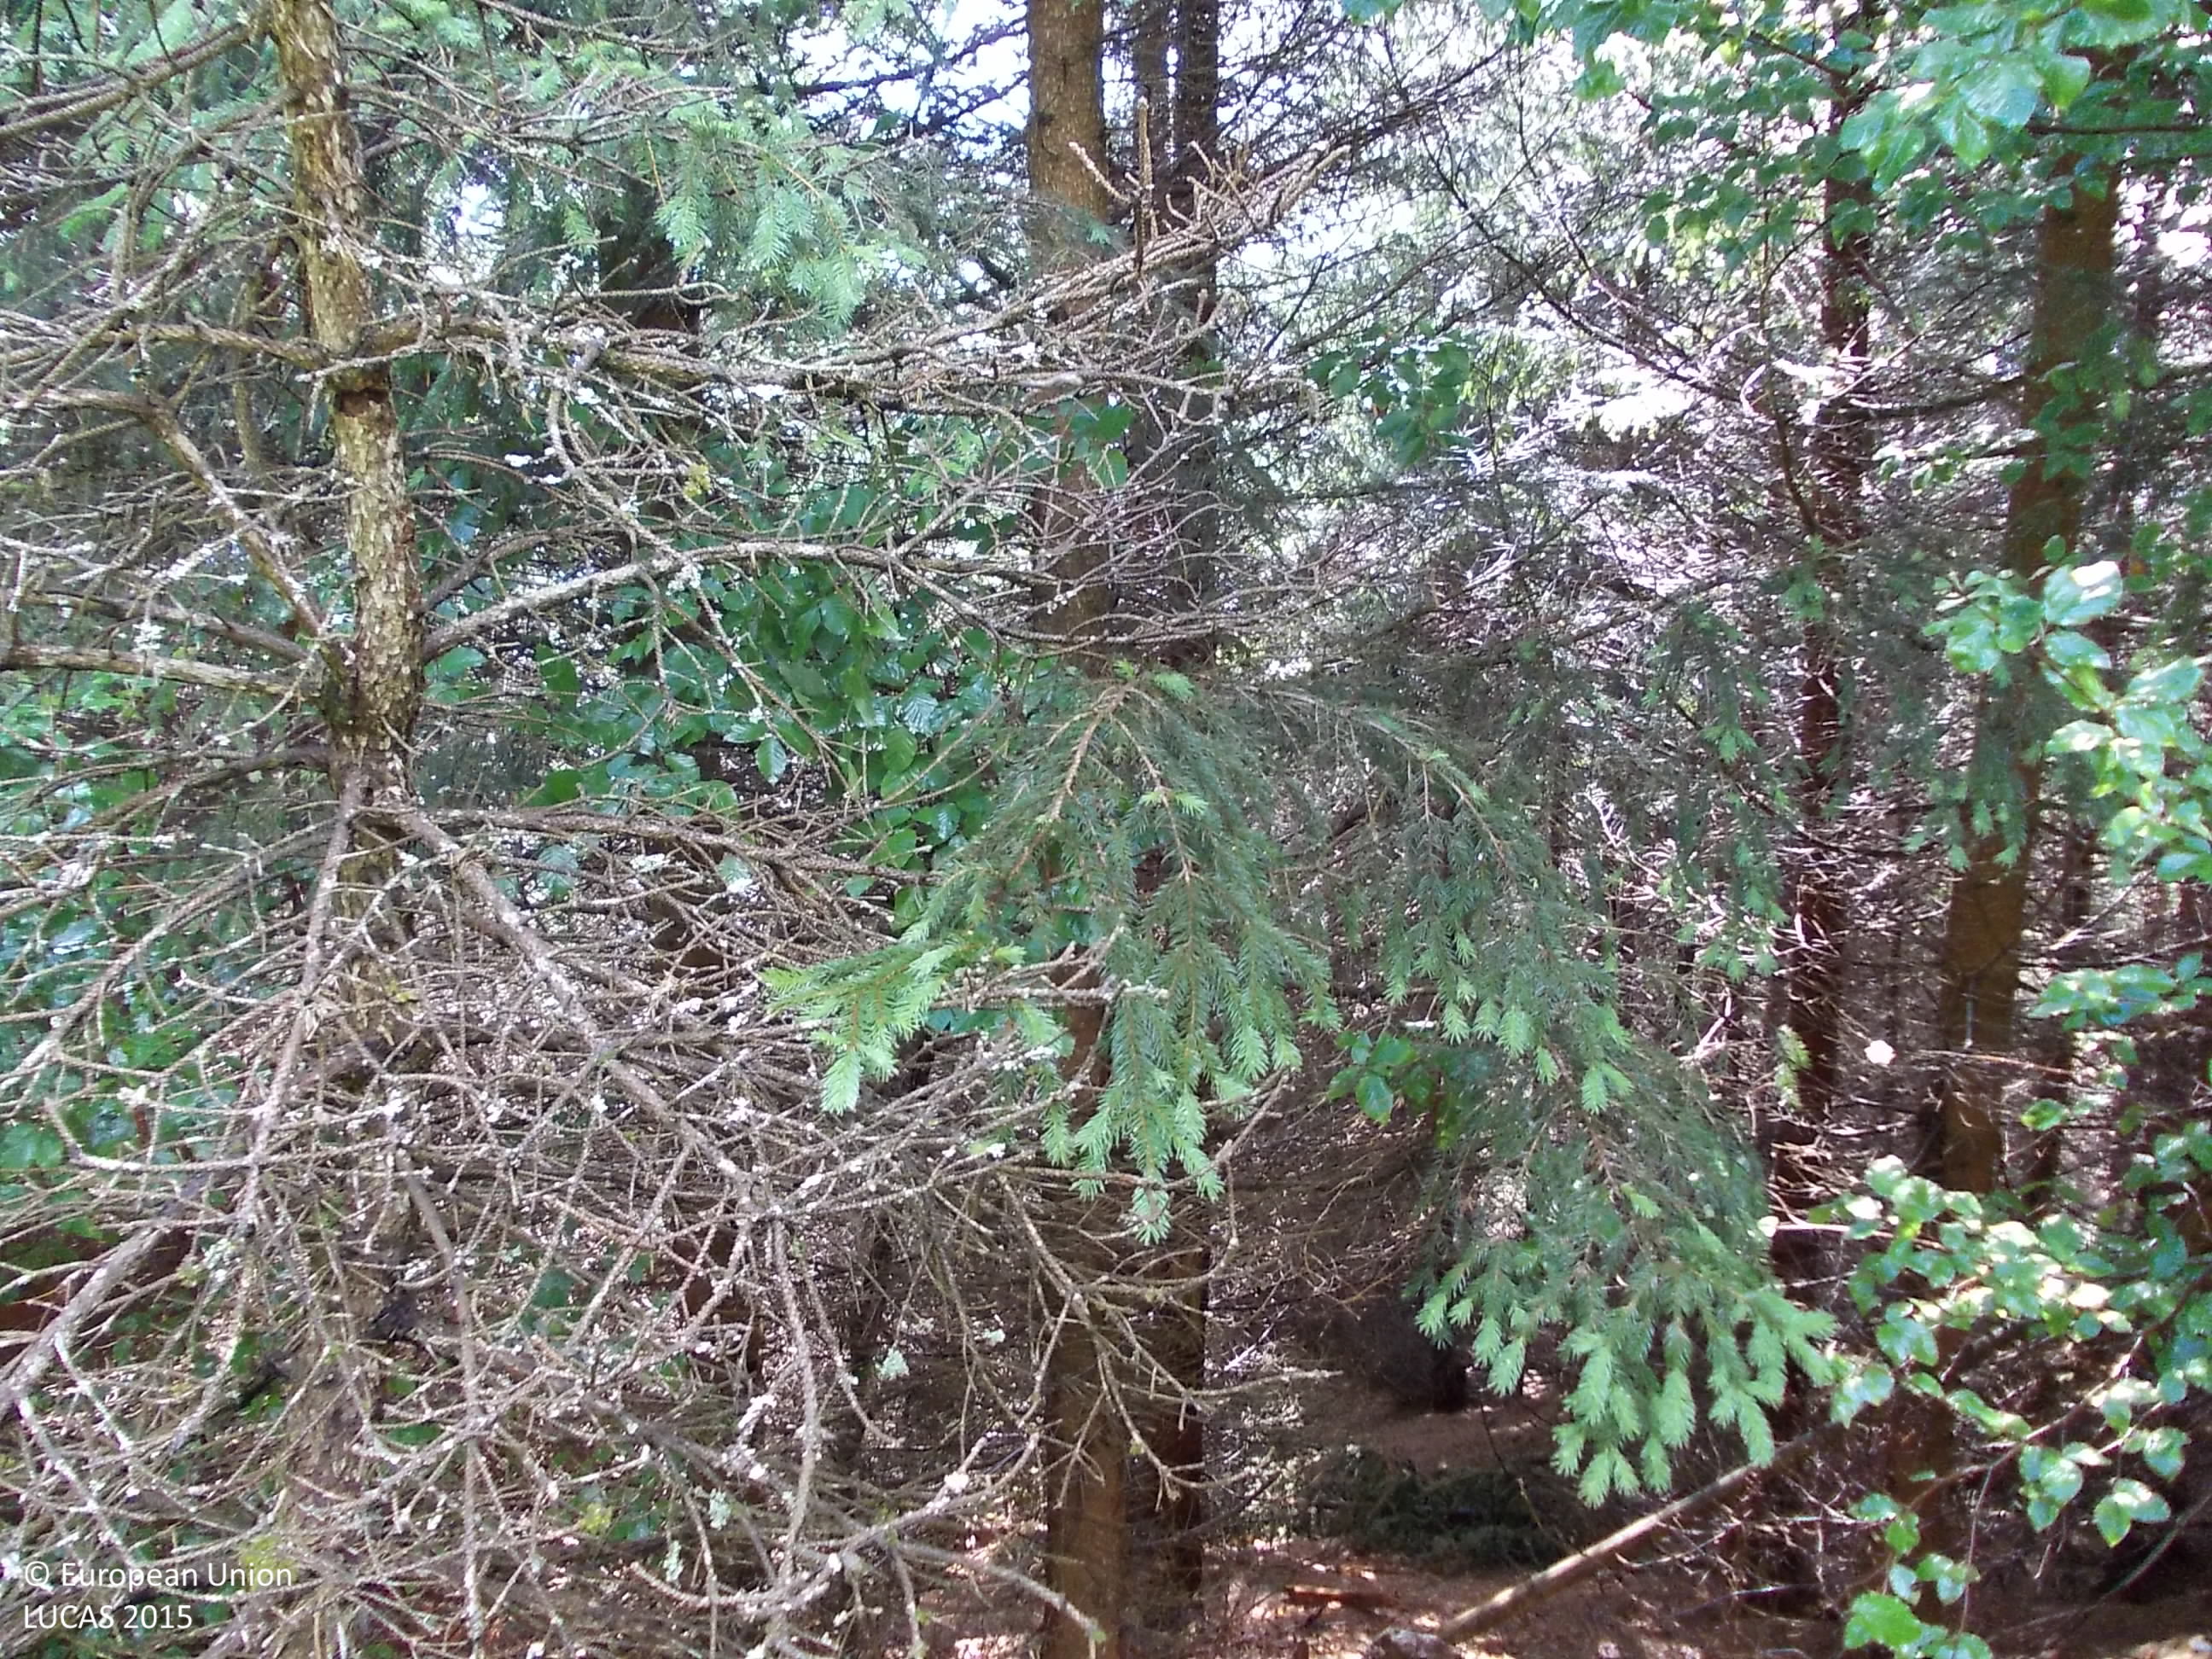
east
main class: Woodland
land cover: Spruce dominated coniferous woodland
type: hemiboreal forest and nemoral coniferous forest and mixed broadleaved-coniferous forest
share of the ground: > 75 %
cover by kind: coniferous forest trees 90 %, broadleaved forest trees 5 %, herbaceous plants 5 %
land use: Forestry
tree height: > 5 m
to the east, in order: Spruce dominated coniferous woodland; Spruce dominated mixed woodland; Tracks; Broadleaved woodland
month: June
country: CZ
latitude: 48.9484
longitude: 13.8645
